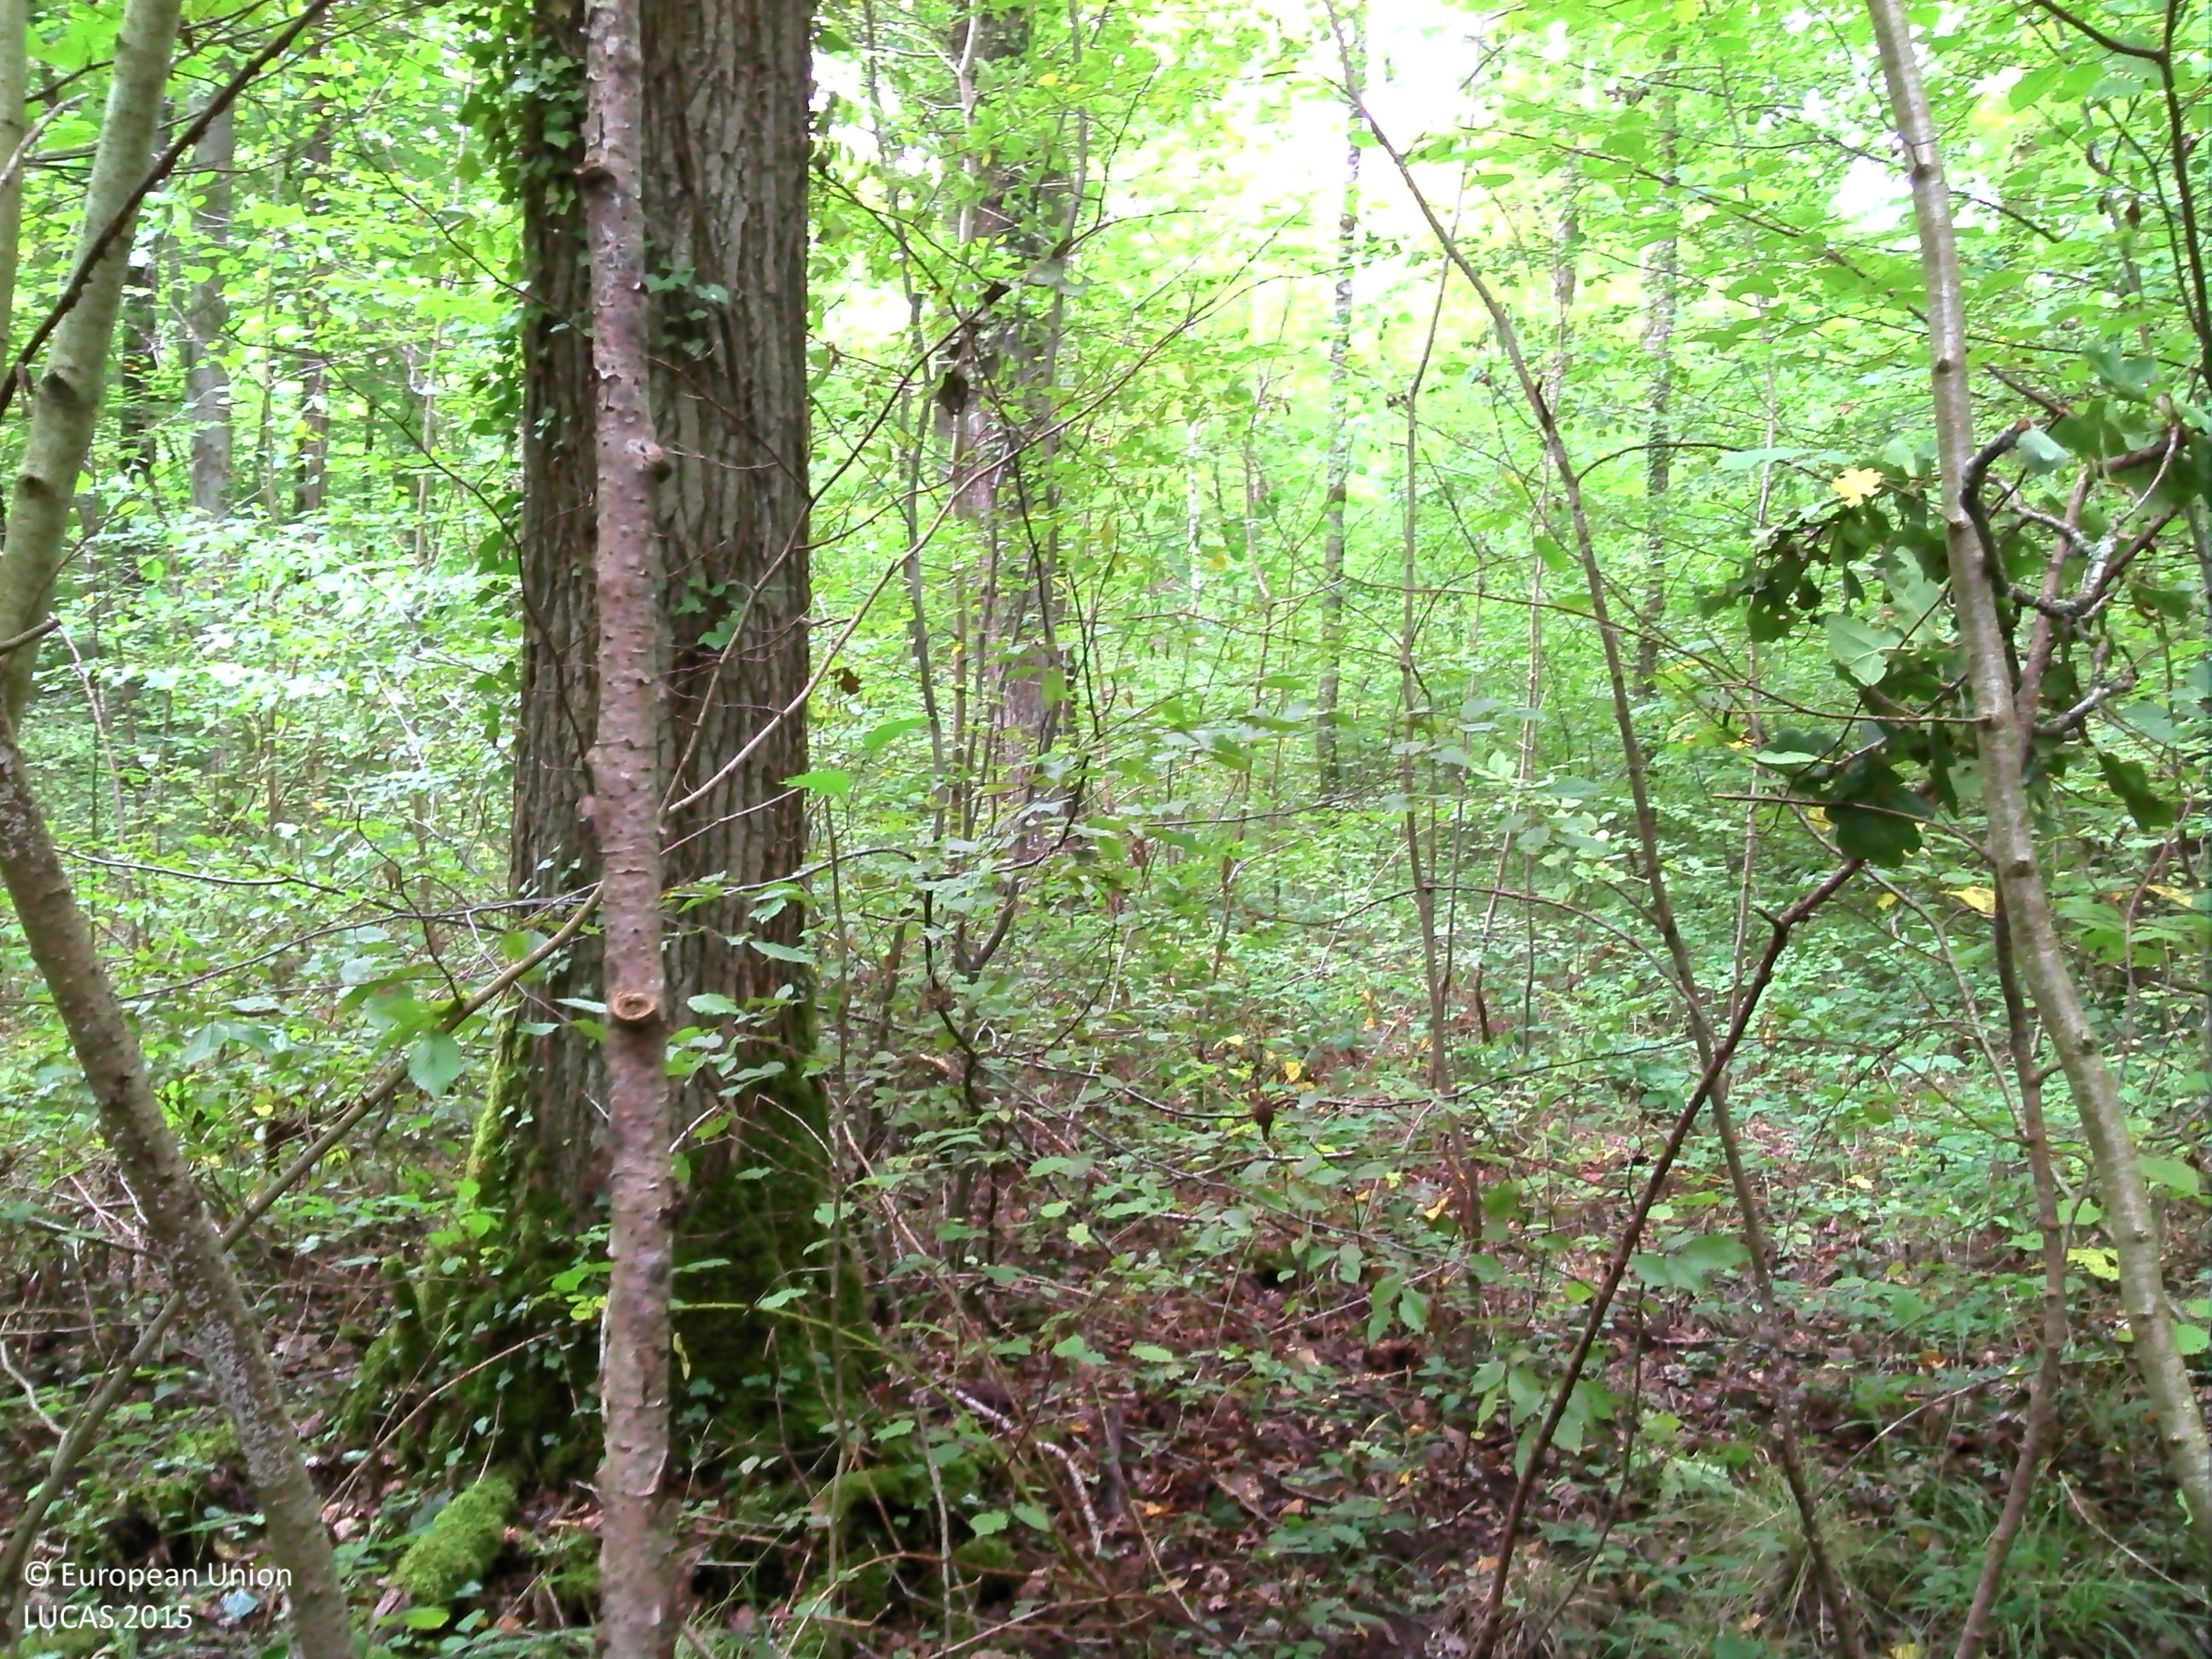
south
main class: Woodland
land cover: Broadleaved woodland
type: mesophytic deciduous forest
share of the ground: > 75 %
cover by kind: broadleaved forest trees 80 %, shrubs 10 %, herbaceous plants 5 %, lichens and mosses 5 %
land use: Forestry
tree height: > 5 m
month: September
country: FR
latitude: 48.3265
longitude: 4.6162
